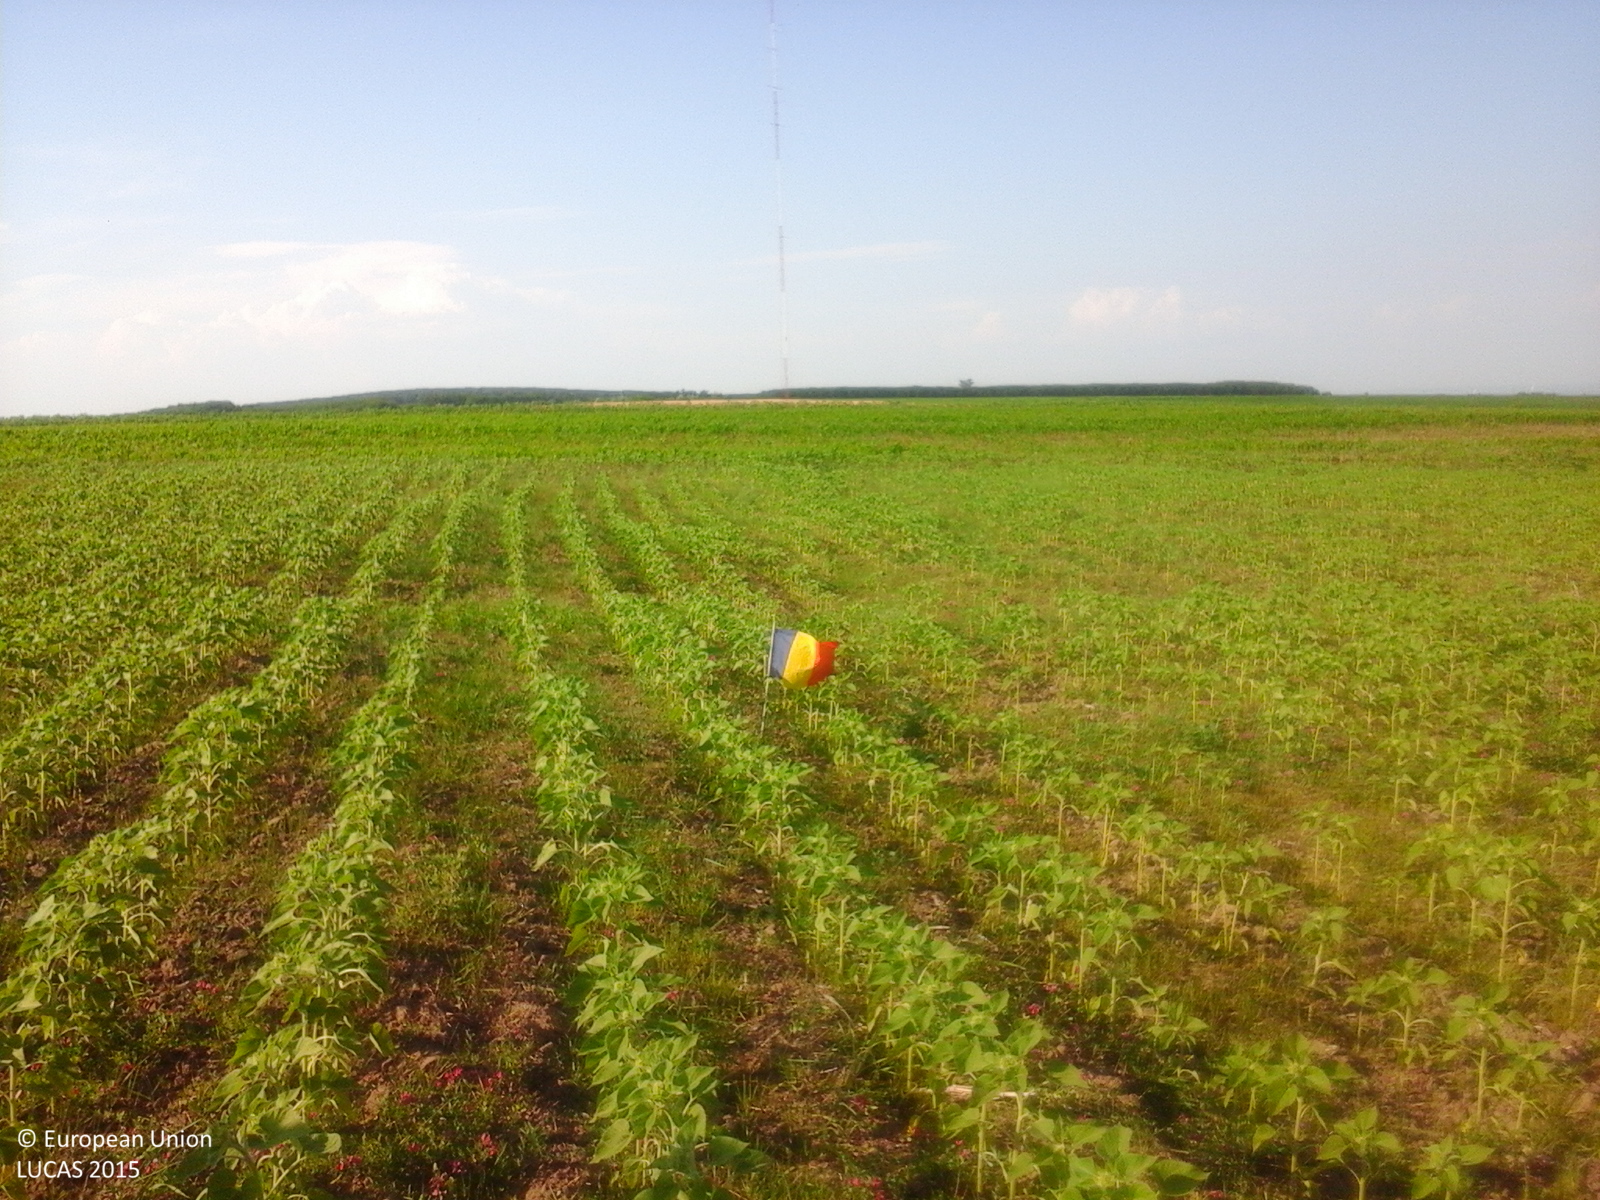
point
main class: Cropland
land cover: Sunflower
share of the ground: 50 - 75 %
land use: Agriculture (excluding fallow land and kitchen gardens)
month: June
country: RO
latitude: 46.7402
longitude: 28.0203
